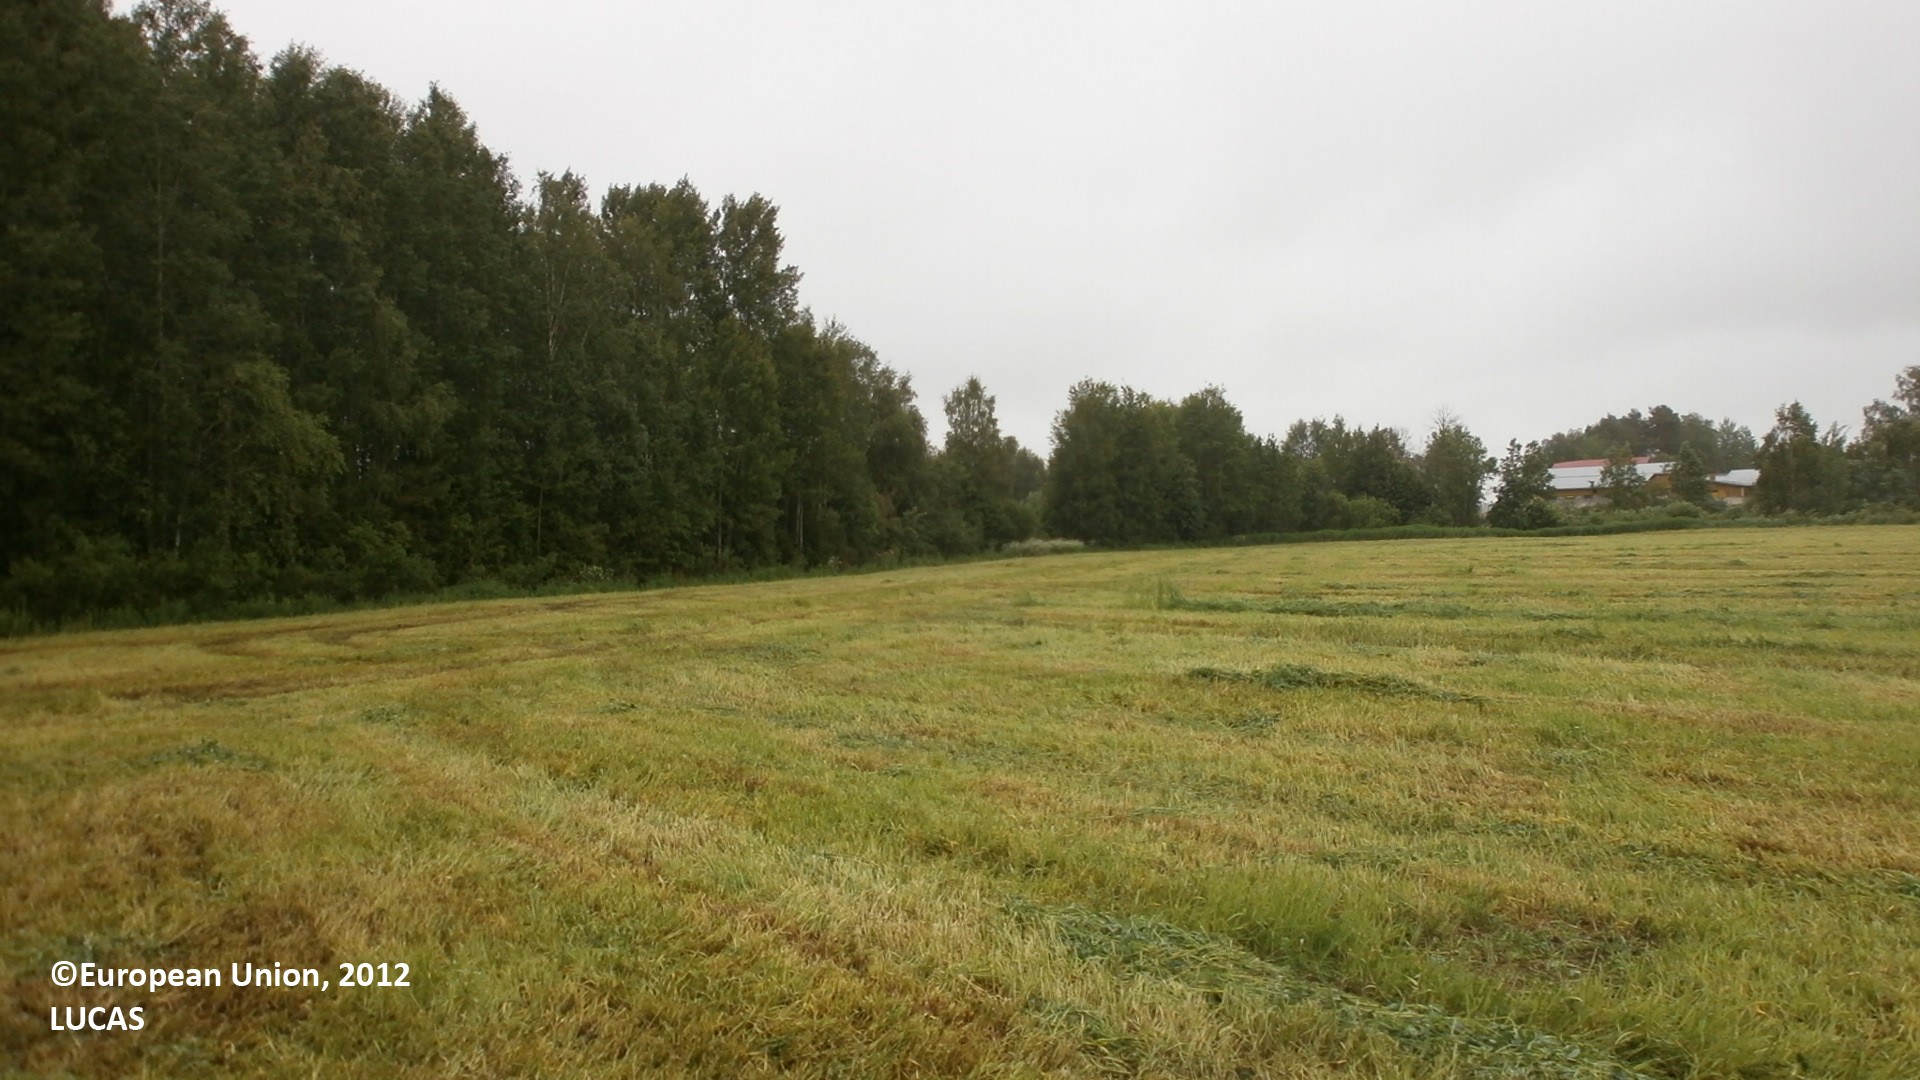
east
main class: Grassland
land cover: Grassland without tree/shrub cover
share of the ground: > 75 %
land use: Agriculture (excluding fallow land and kitchen gardens)
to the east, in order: Grassland without tree/shrub cover; Shruby margins; Ditches and canals; Broadleaved woodland; Ditches and canals; Shruby margins; Grassland without tree/shrub cover; Spontaneously vegetated surfaces; Inland running water; Grassland with sparse tree/shrub cover
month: June
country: FI
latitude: 64.6281
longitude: 25.1190
